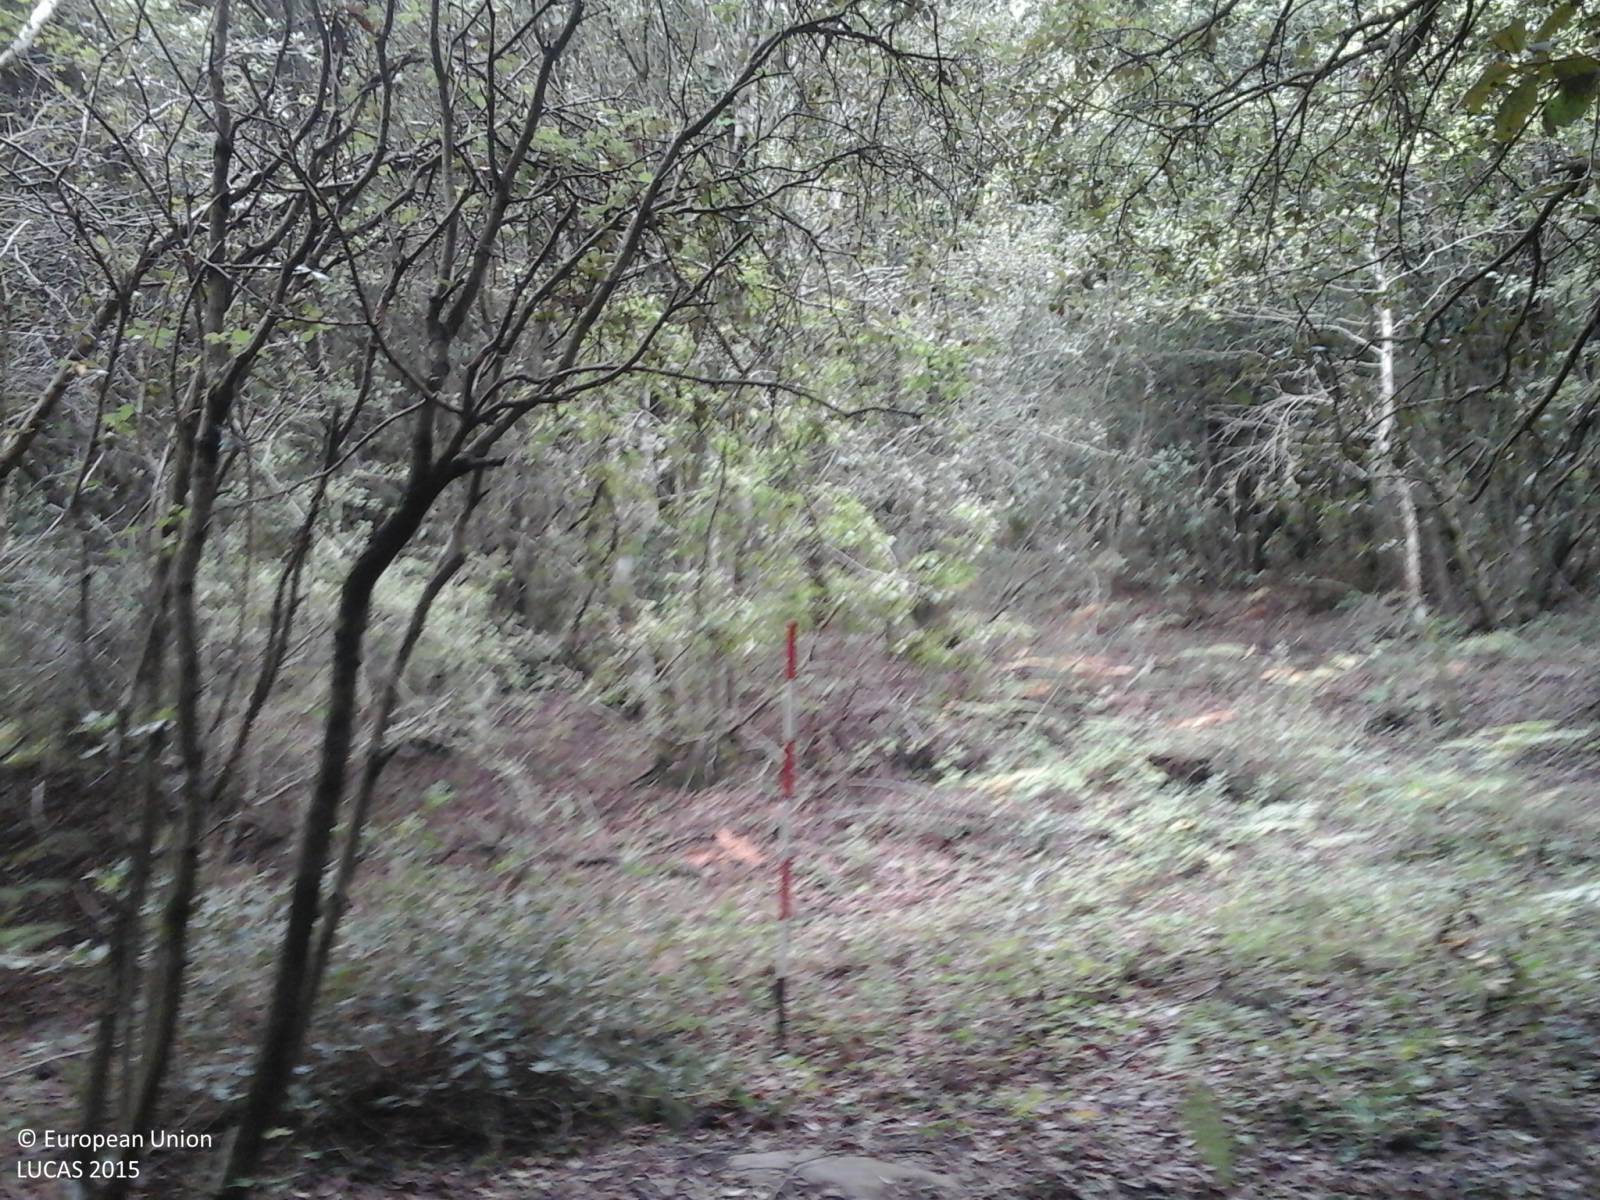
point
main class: Woodland
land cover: Broadleaved woodland
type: broadleaved evergreen forest
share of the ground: > 75 %
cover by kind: broadleaved forest trees 100 %
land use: Forestry
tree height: > 5 m
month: September
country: IT
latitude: 40.2403
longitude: 8.6787
